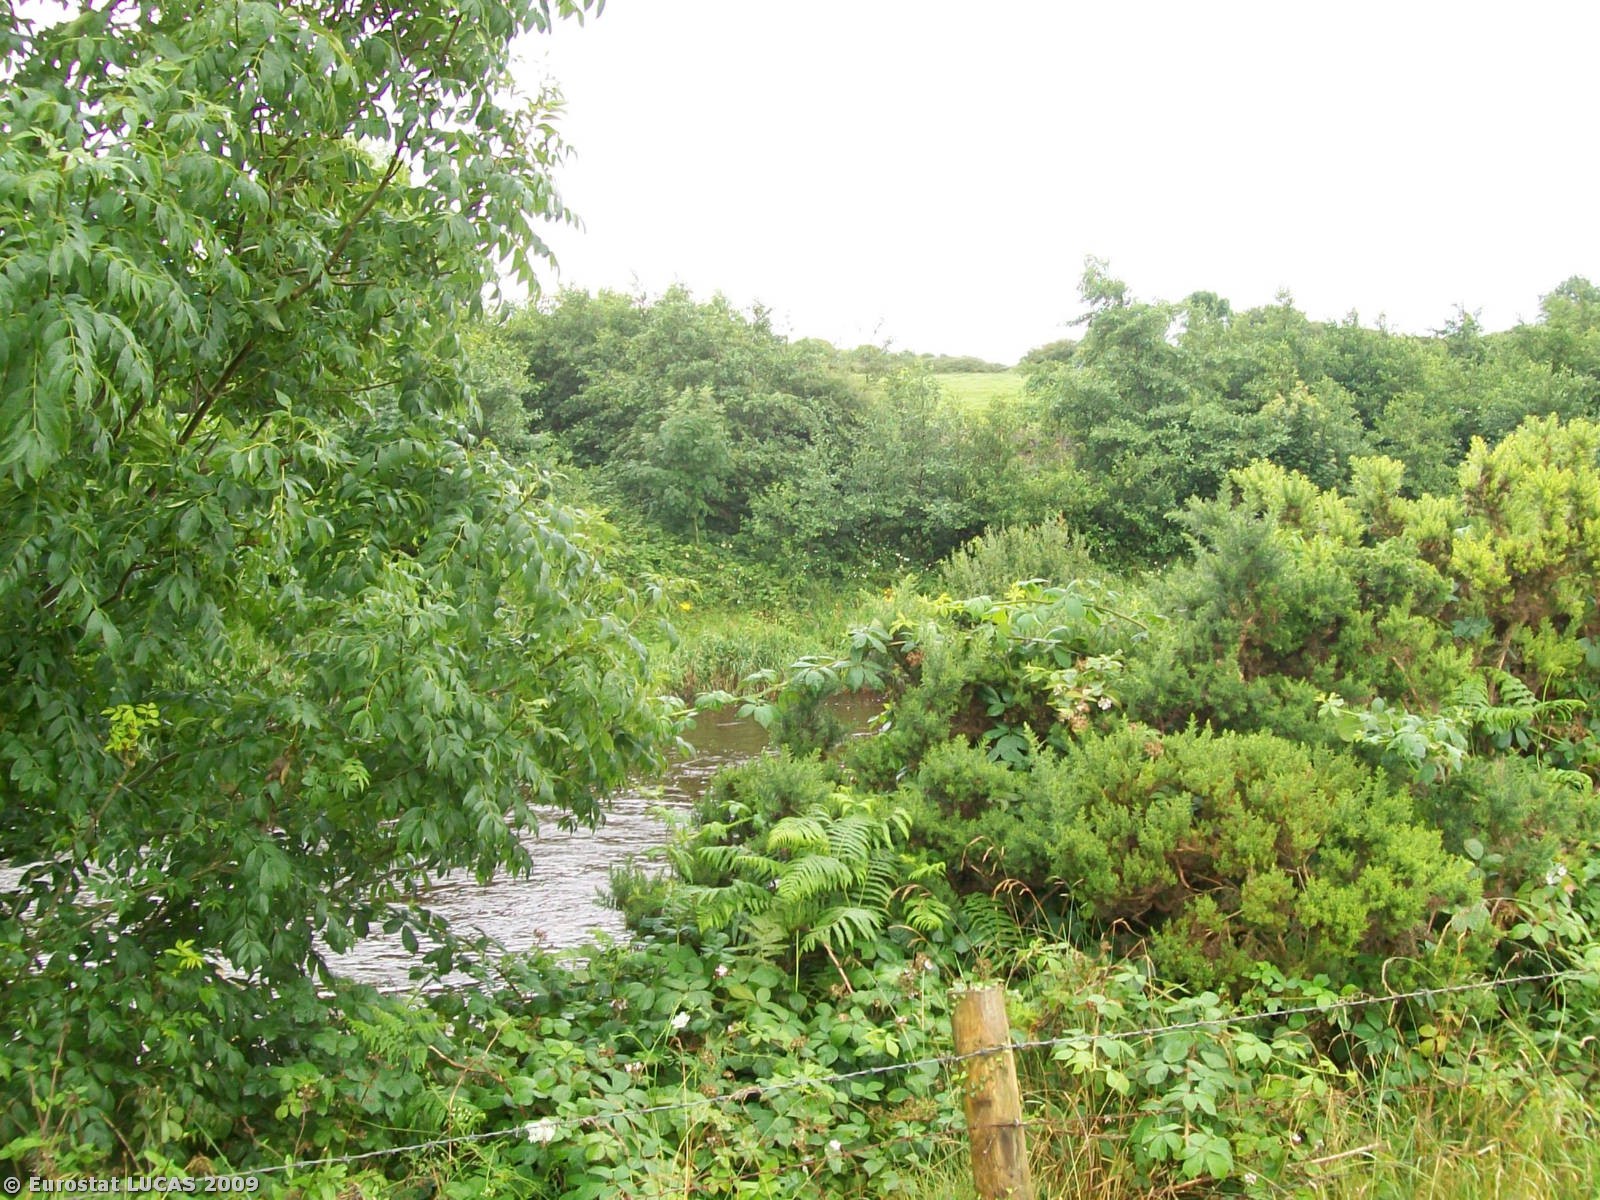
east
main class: Grassland
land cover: Grassland without tree/shrub cover
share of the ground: > 75 %
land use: Agriculture (excluding fallow land and kitchen gardens)
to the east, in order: Grassland without tree/shrub cover; Fences; Managed hedges; Inland running water; Grassland without tree/shrub cover; Abandoned hedges; Fences; Grassland without tree/shrub cover
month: July
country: IE
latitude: 53.9361
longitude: -9.0880
